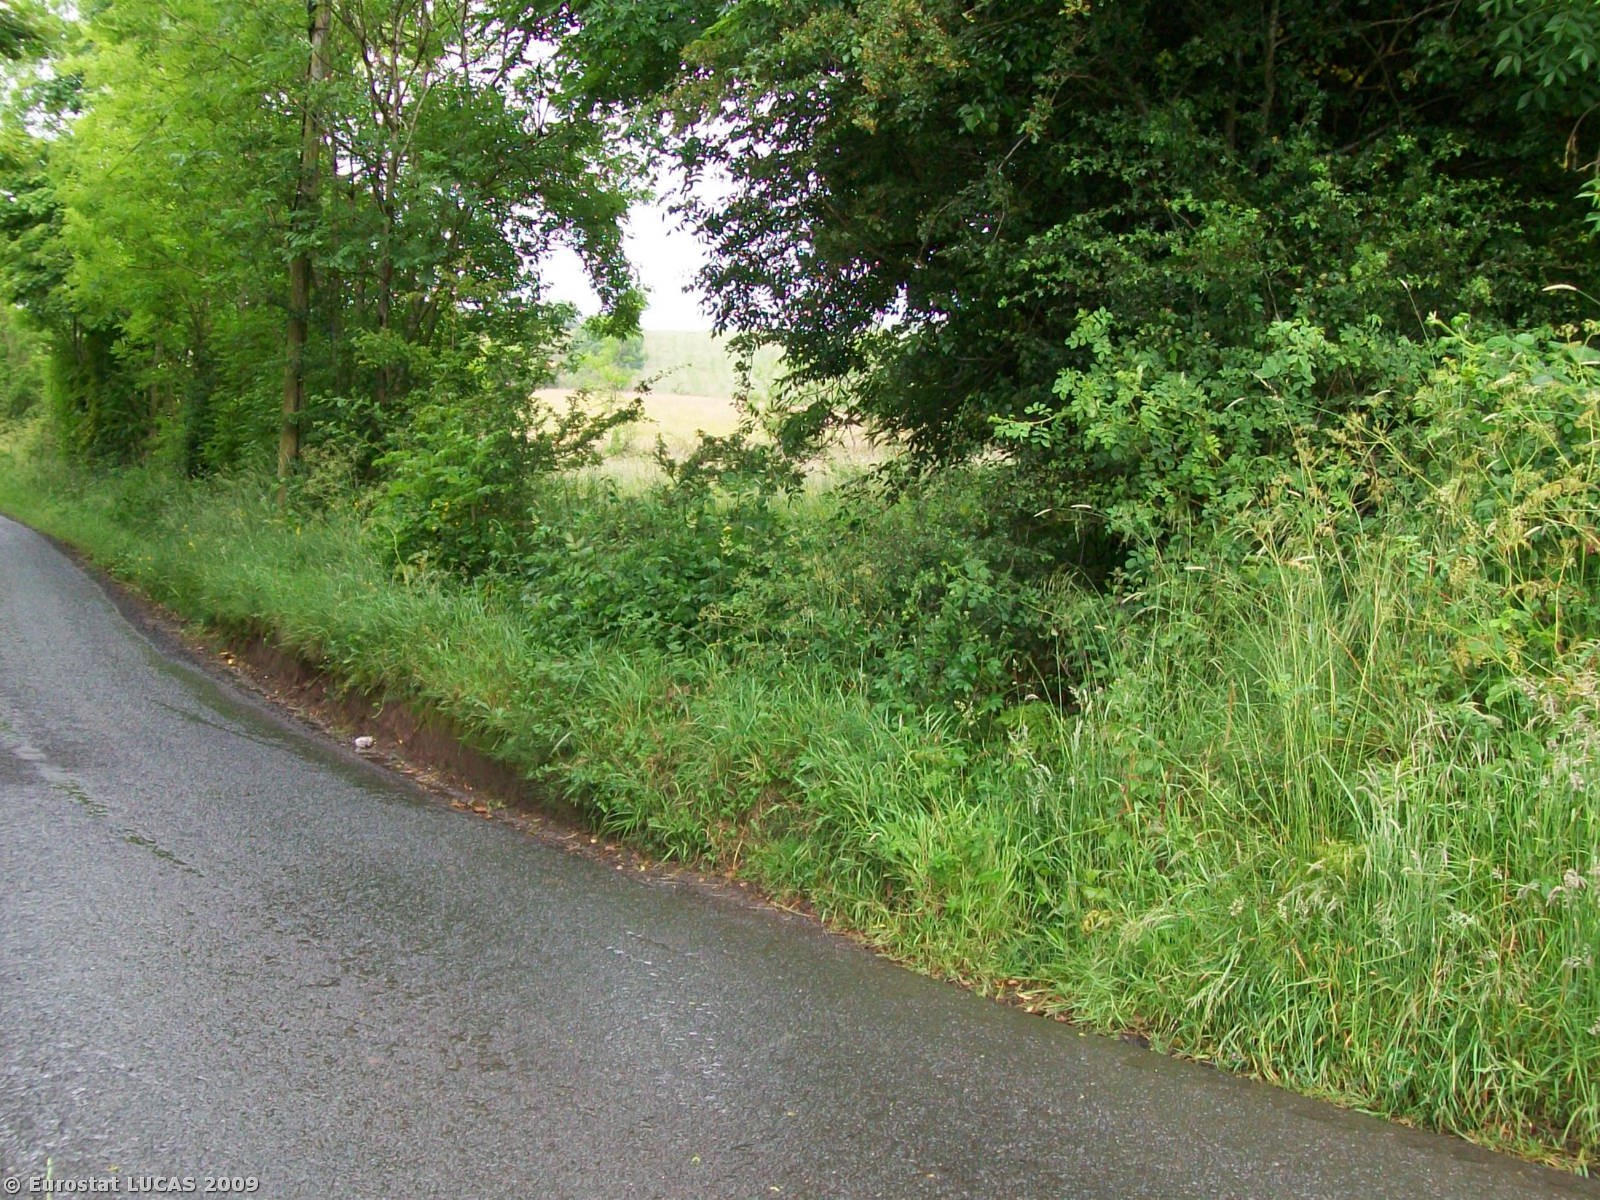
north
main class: Grassland
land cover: Grassland without tree/shrub cover
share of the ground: > 75 %
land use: Agriculture (excluding fallow land and kitchen gardens)
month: June
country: GB
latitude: 54.4830
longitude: -7.4251
